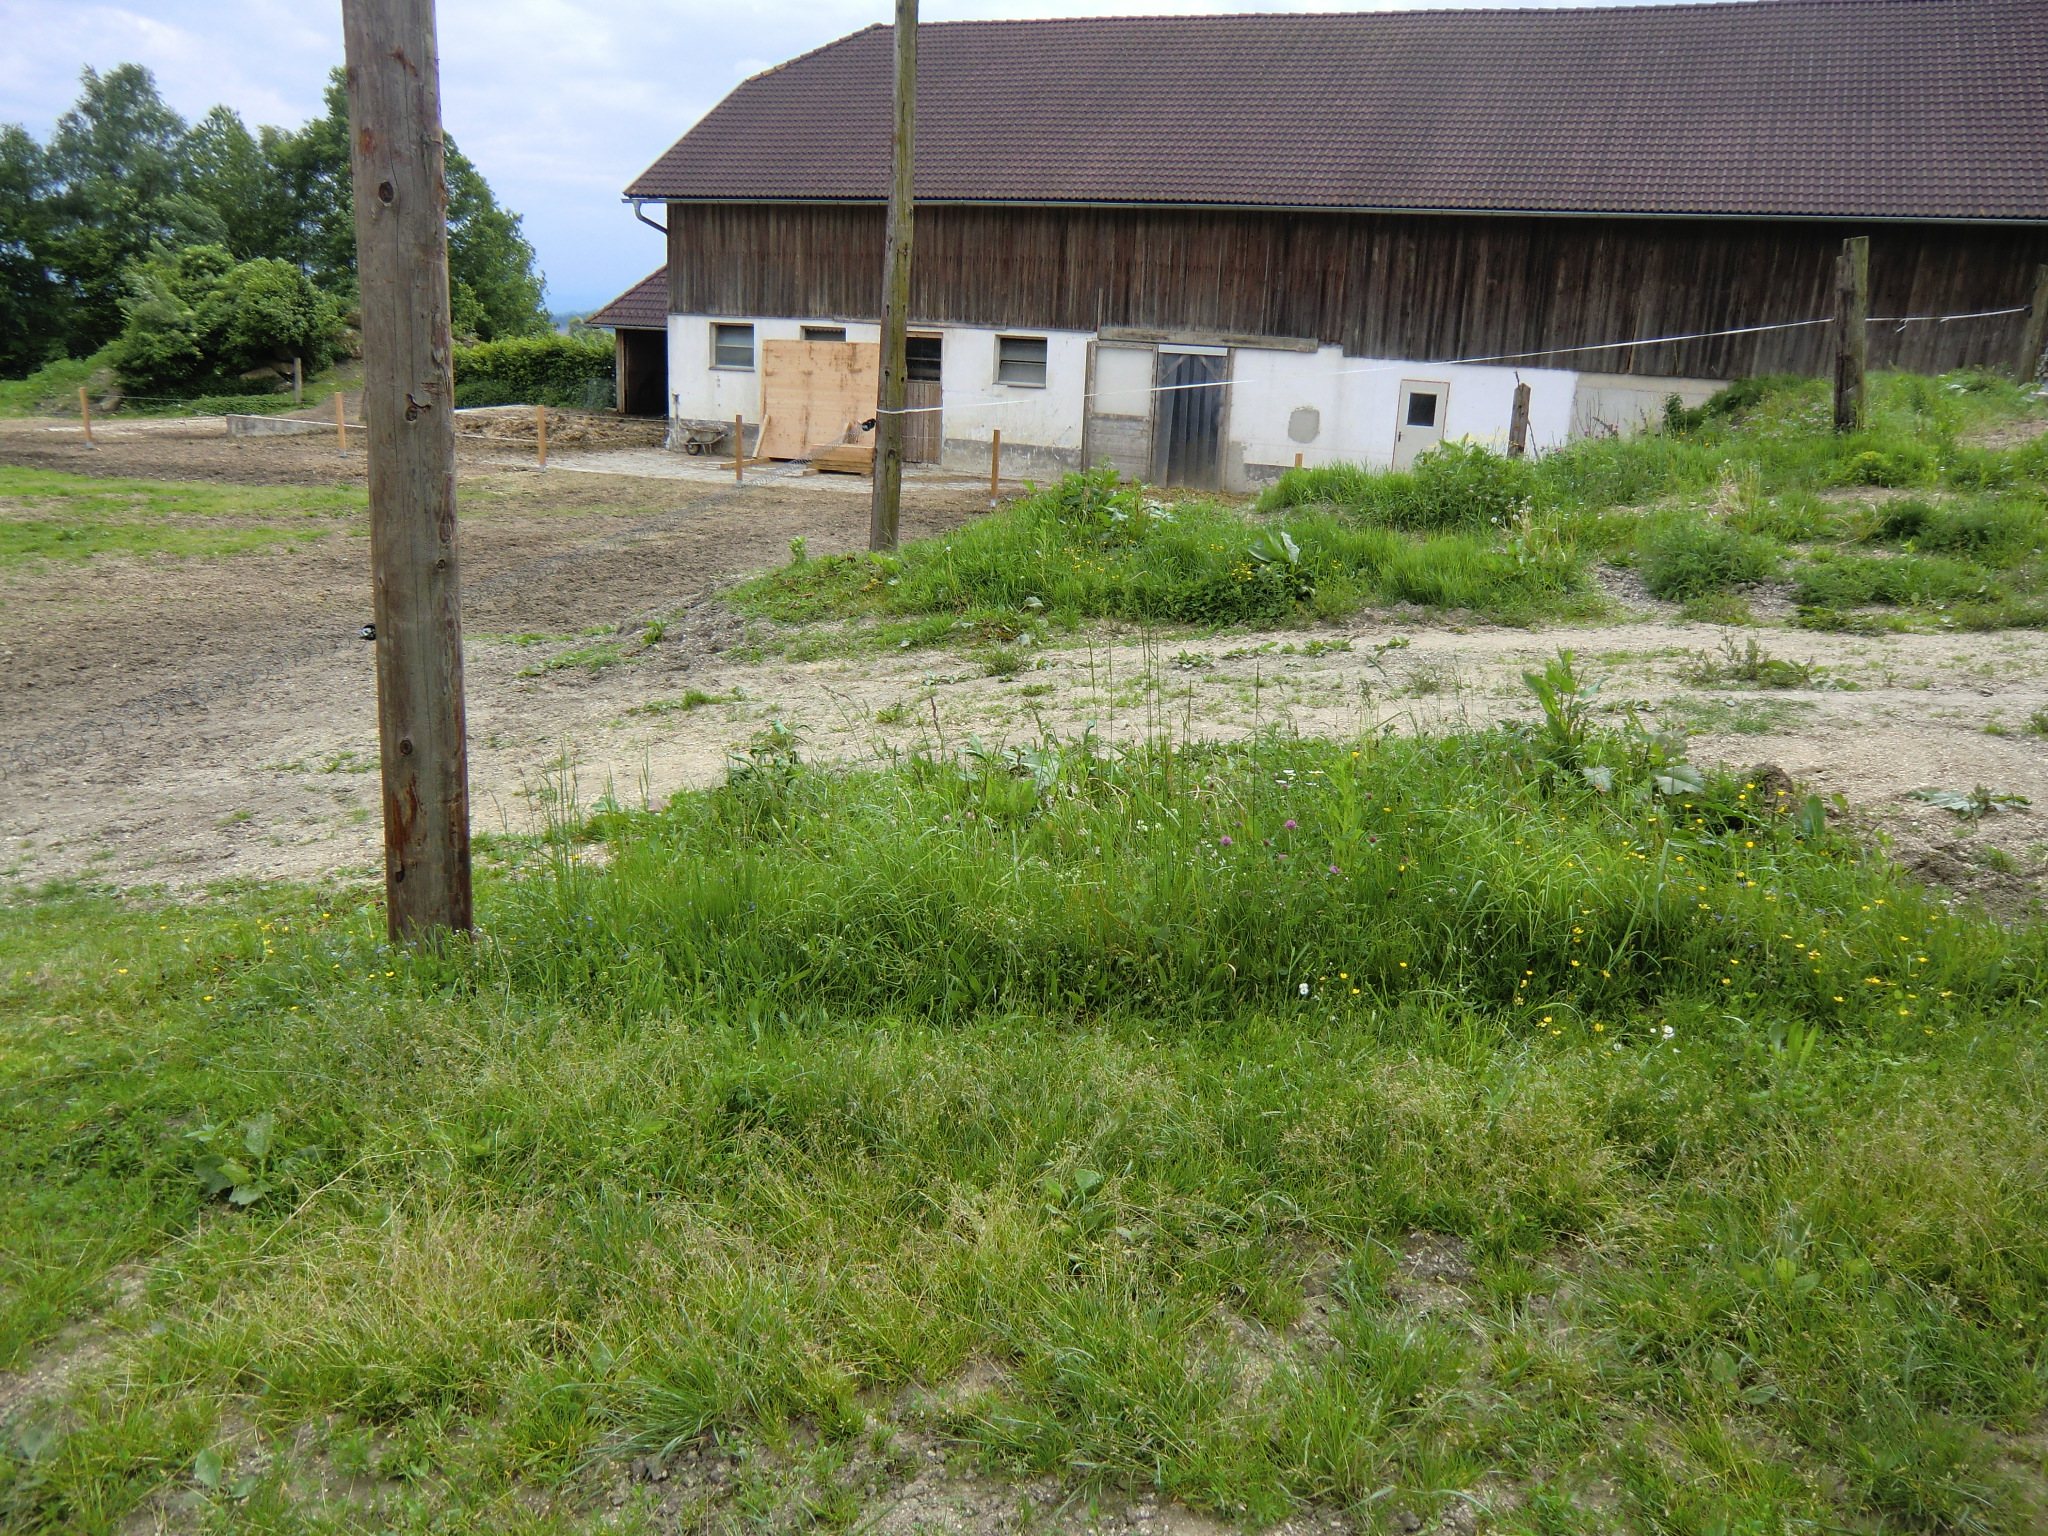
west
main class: Grassland
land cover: Grassland with sparse tree/shrub cover
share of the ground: > 75 %
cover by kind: herbaceous plants 95 %, broadleaved forest trees 5 %
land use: Agriculture (excluding fallow land and kitchen gardens)
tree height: > 5 m
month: May
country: AT
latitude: 48.3107
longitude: 14.9497
